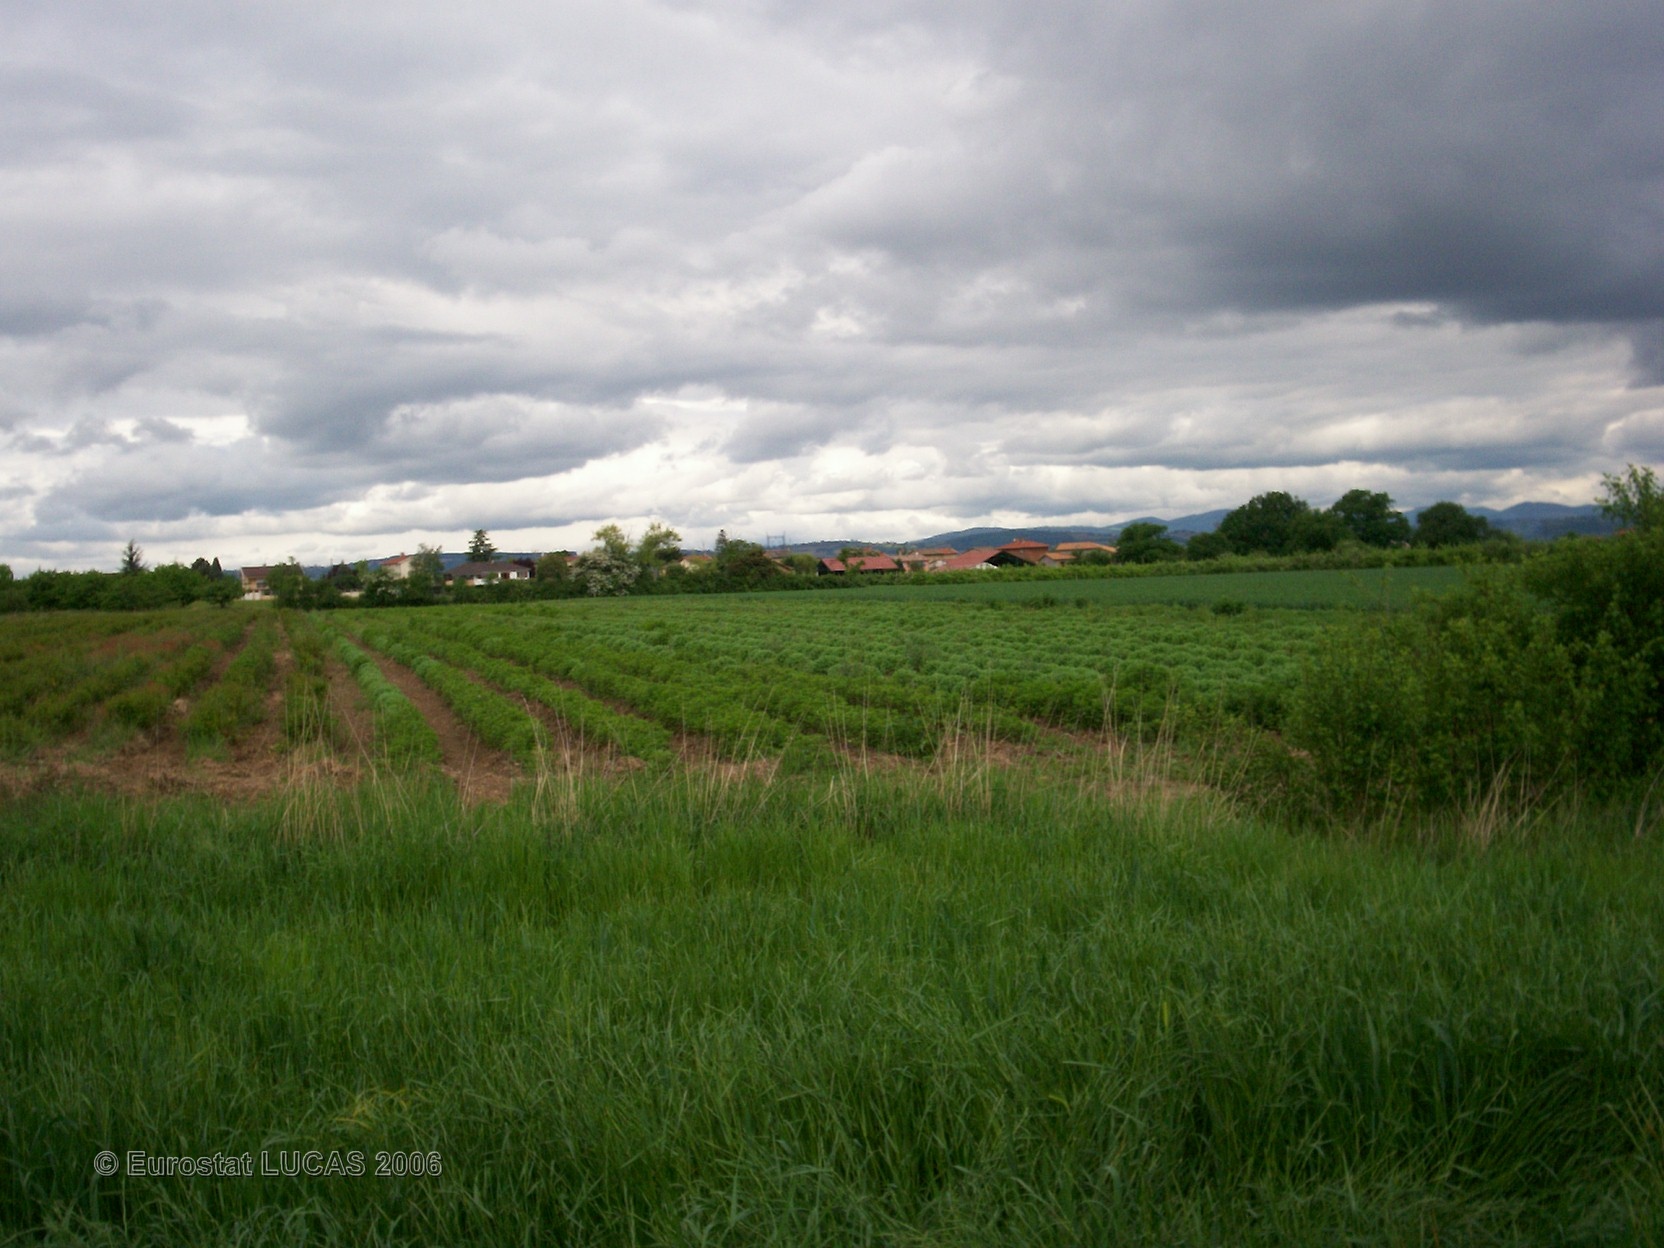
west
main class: Grassland
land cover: Grassland without tree/shrub cover
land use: Agriculture (excluding fallow land and kitchen gardens)
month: May
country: FR
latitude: 45.8811
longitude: 4.7848
